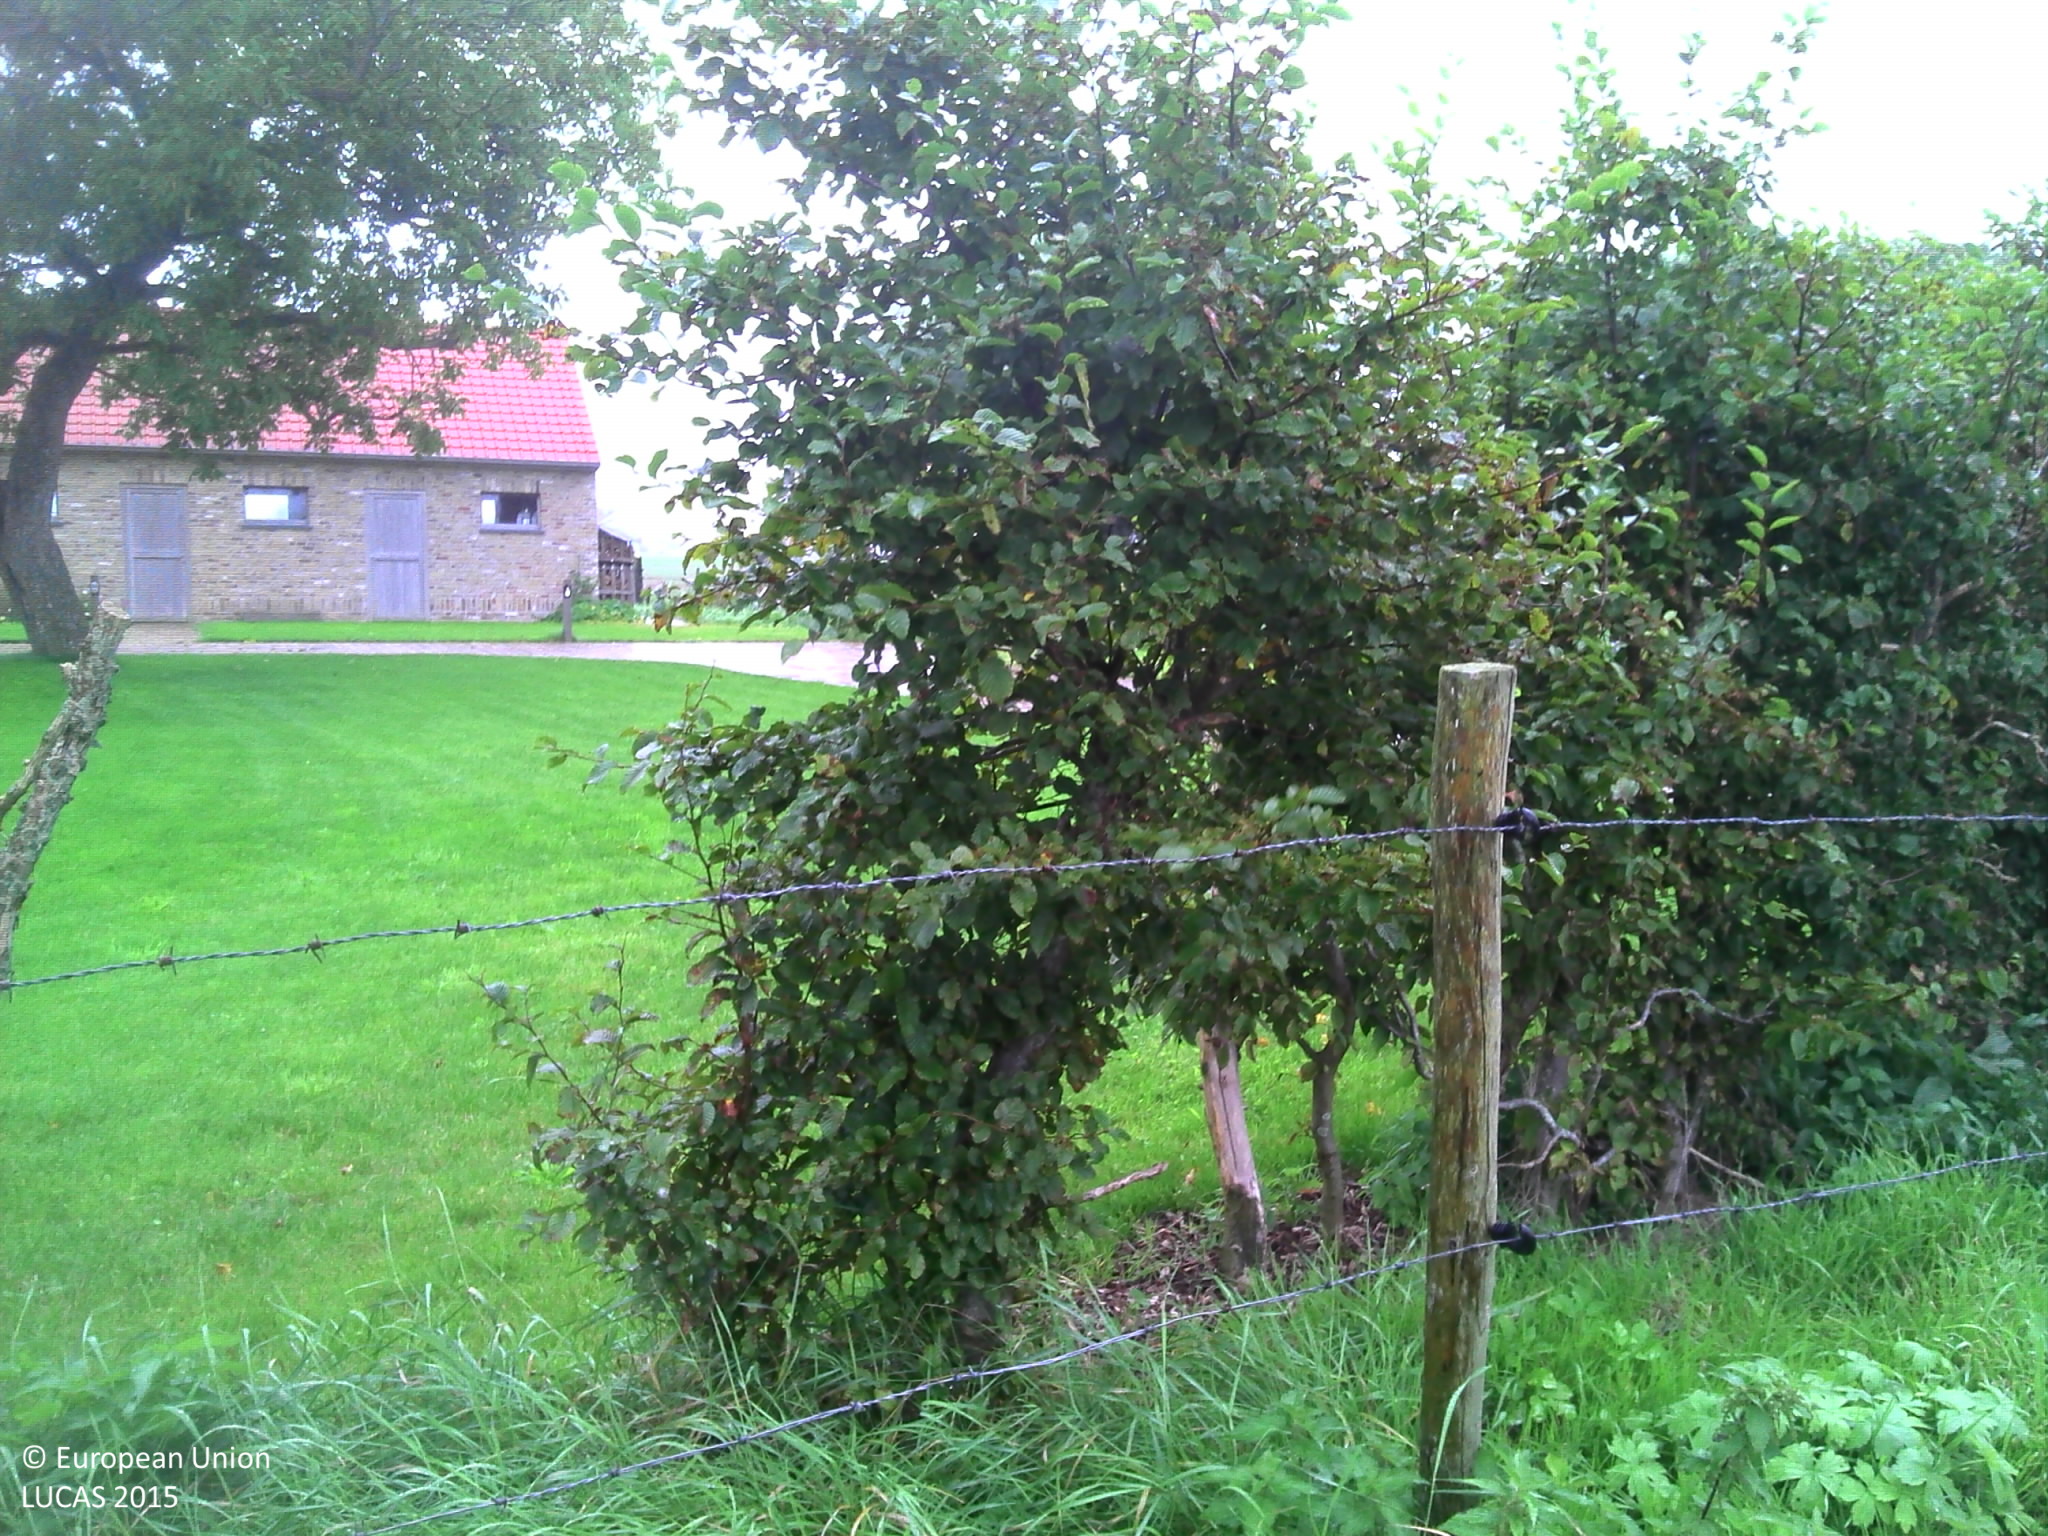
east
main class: Grassland
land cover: Grassland without tree/shrub cover
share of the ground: > 75 %
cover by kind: herbaceous plants 100 %
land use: Agriculture (excluding fallow land and kitchen gardens)
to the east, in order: Grassland without tree/shrub cover; Fences; Artificial constructions in urban areas; Grassland without tree/shrub cover; Fences; Common wheat; Other fibre and oleaginous crops
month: September
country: BE
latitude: 51.0532
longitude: 2.7270
